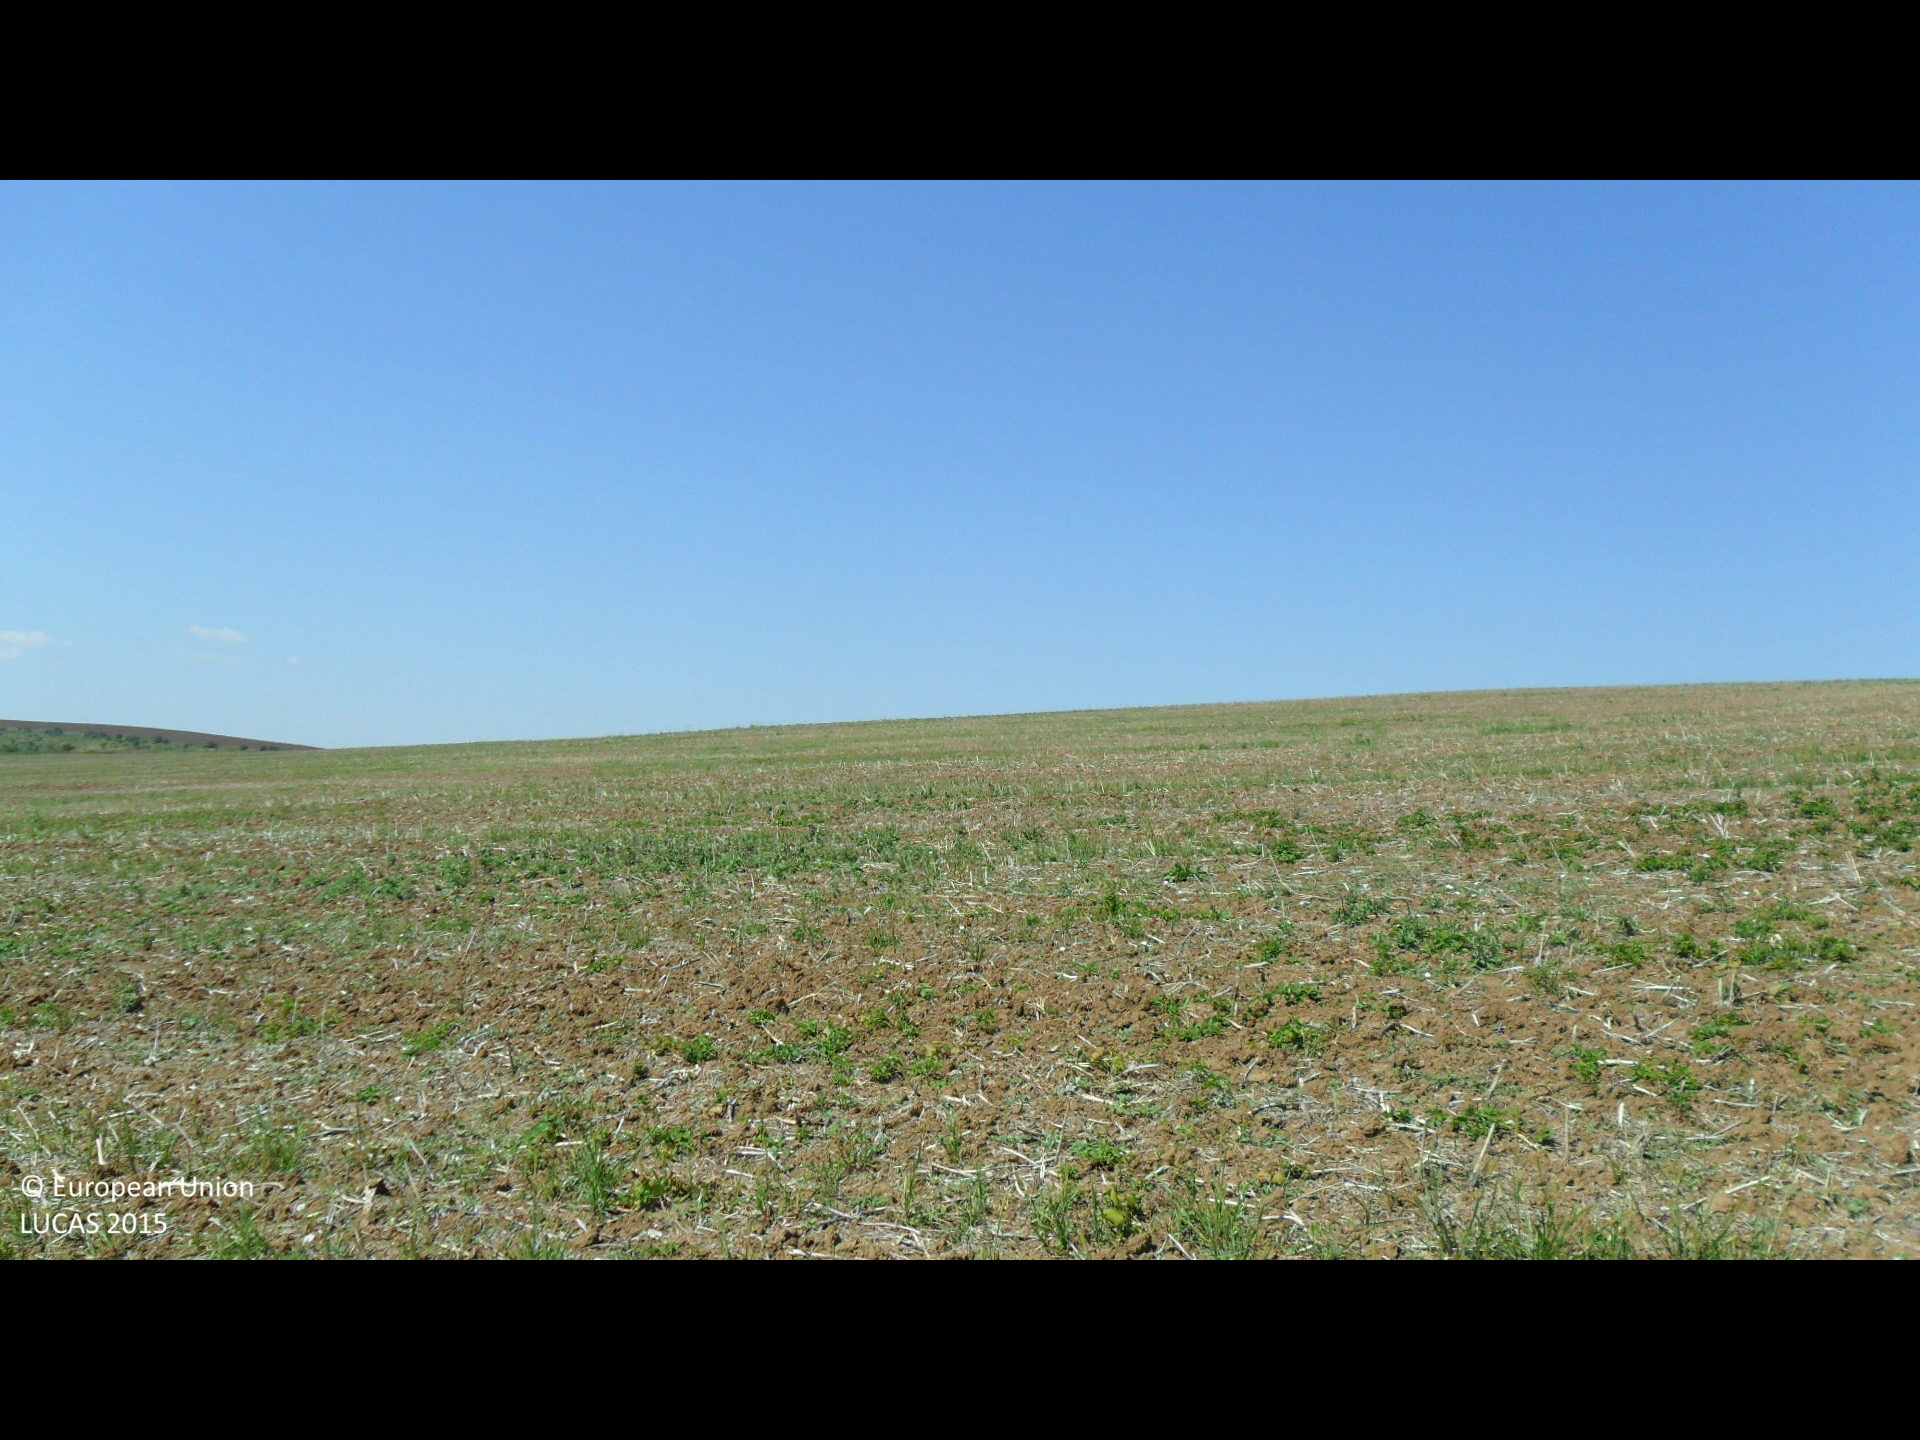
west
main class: Cropland
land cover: Rape and turnip rape
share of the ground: < 10 %
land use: Agriculture (excluding fallow land and kitchen gardens)
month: August
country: BG
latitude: 43.5021
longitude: 26.2384
